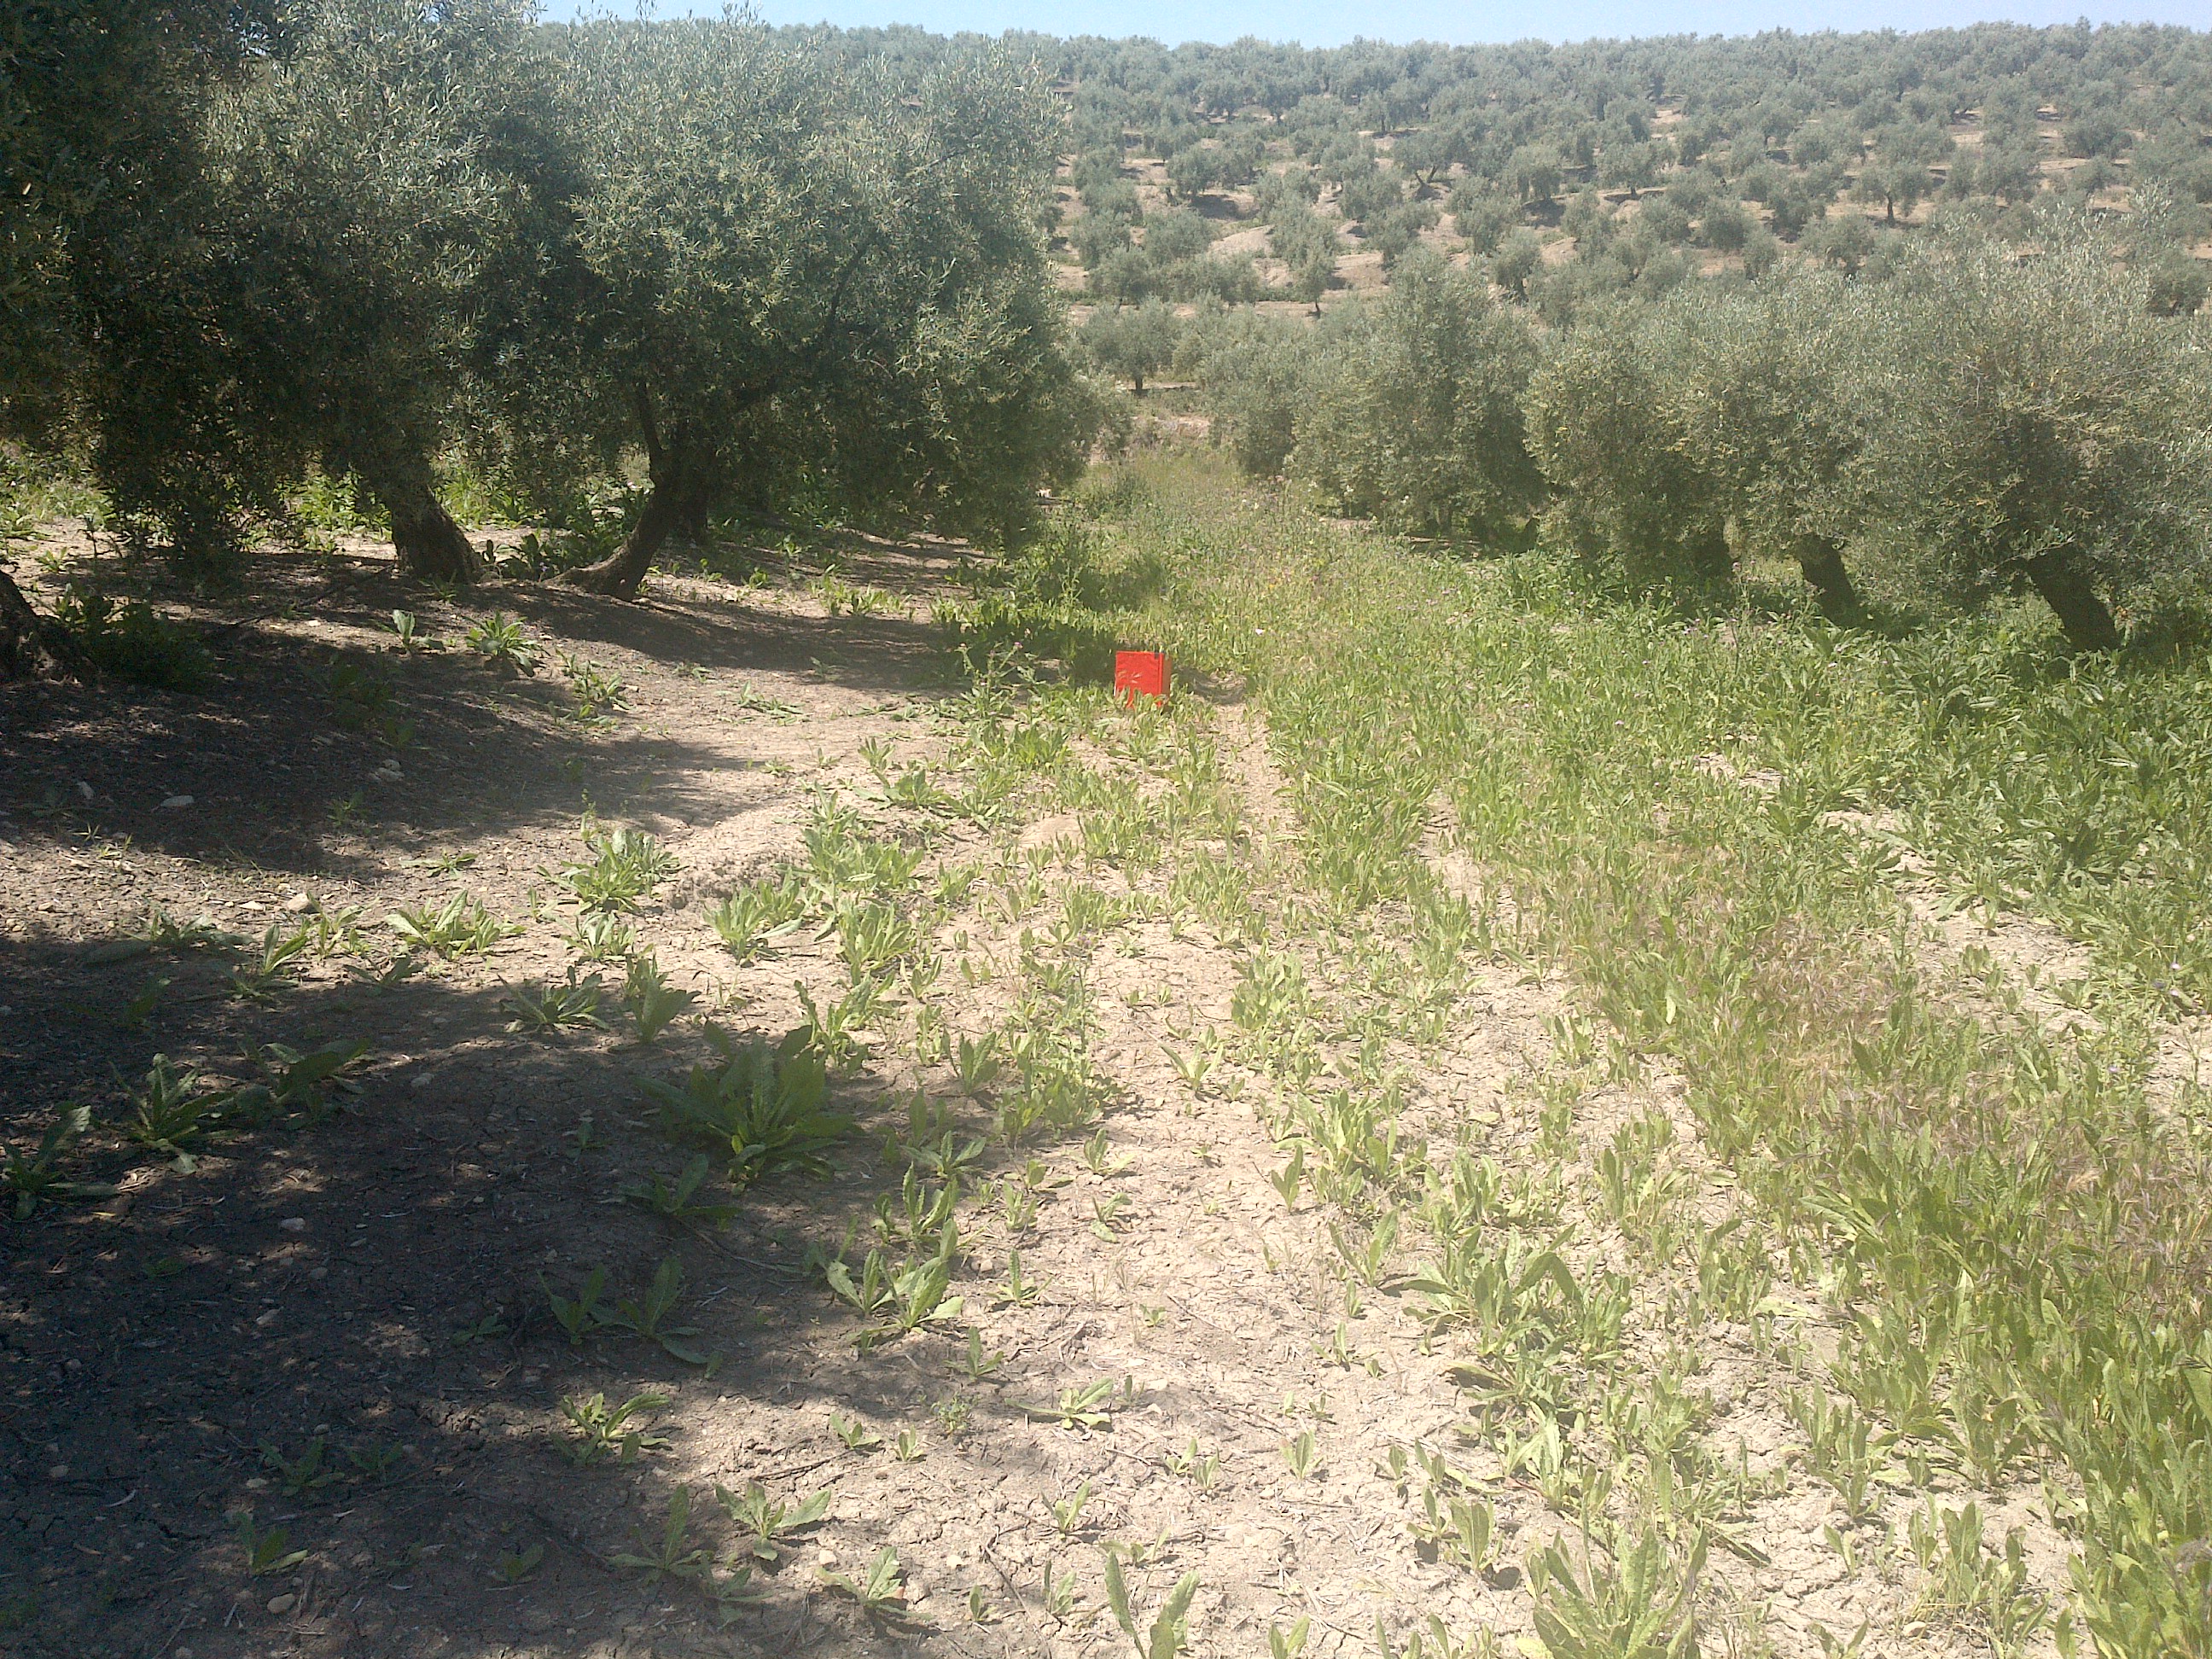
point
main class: Cropland
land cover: Olive groves
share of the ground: 50 - 75 %
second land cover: Spontaneously vegetated surfaces
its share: 50 - 75 %
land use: Agriculture (excluding fallow land and kitchen gardens)
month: May
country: ES
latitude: 37.6805
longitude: -4.6018
